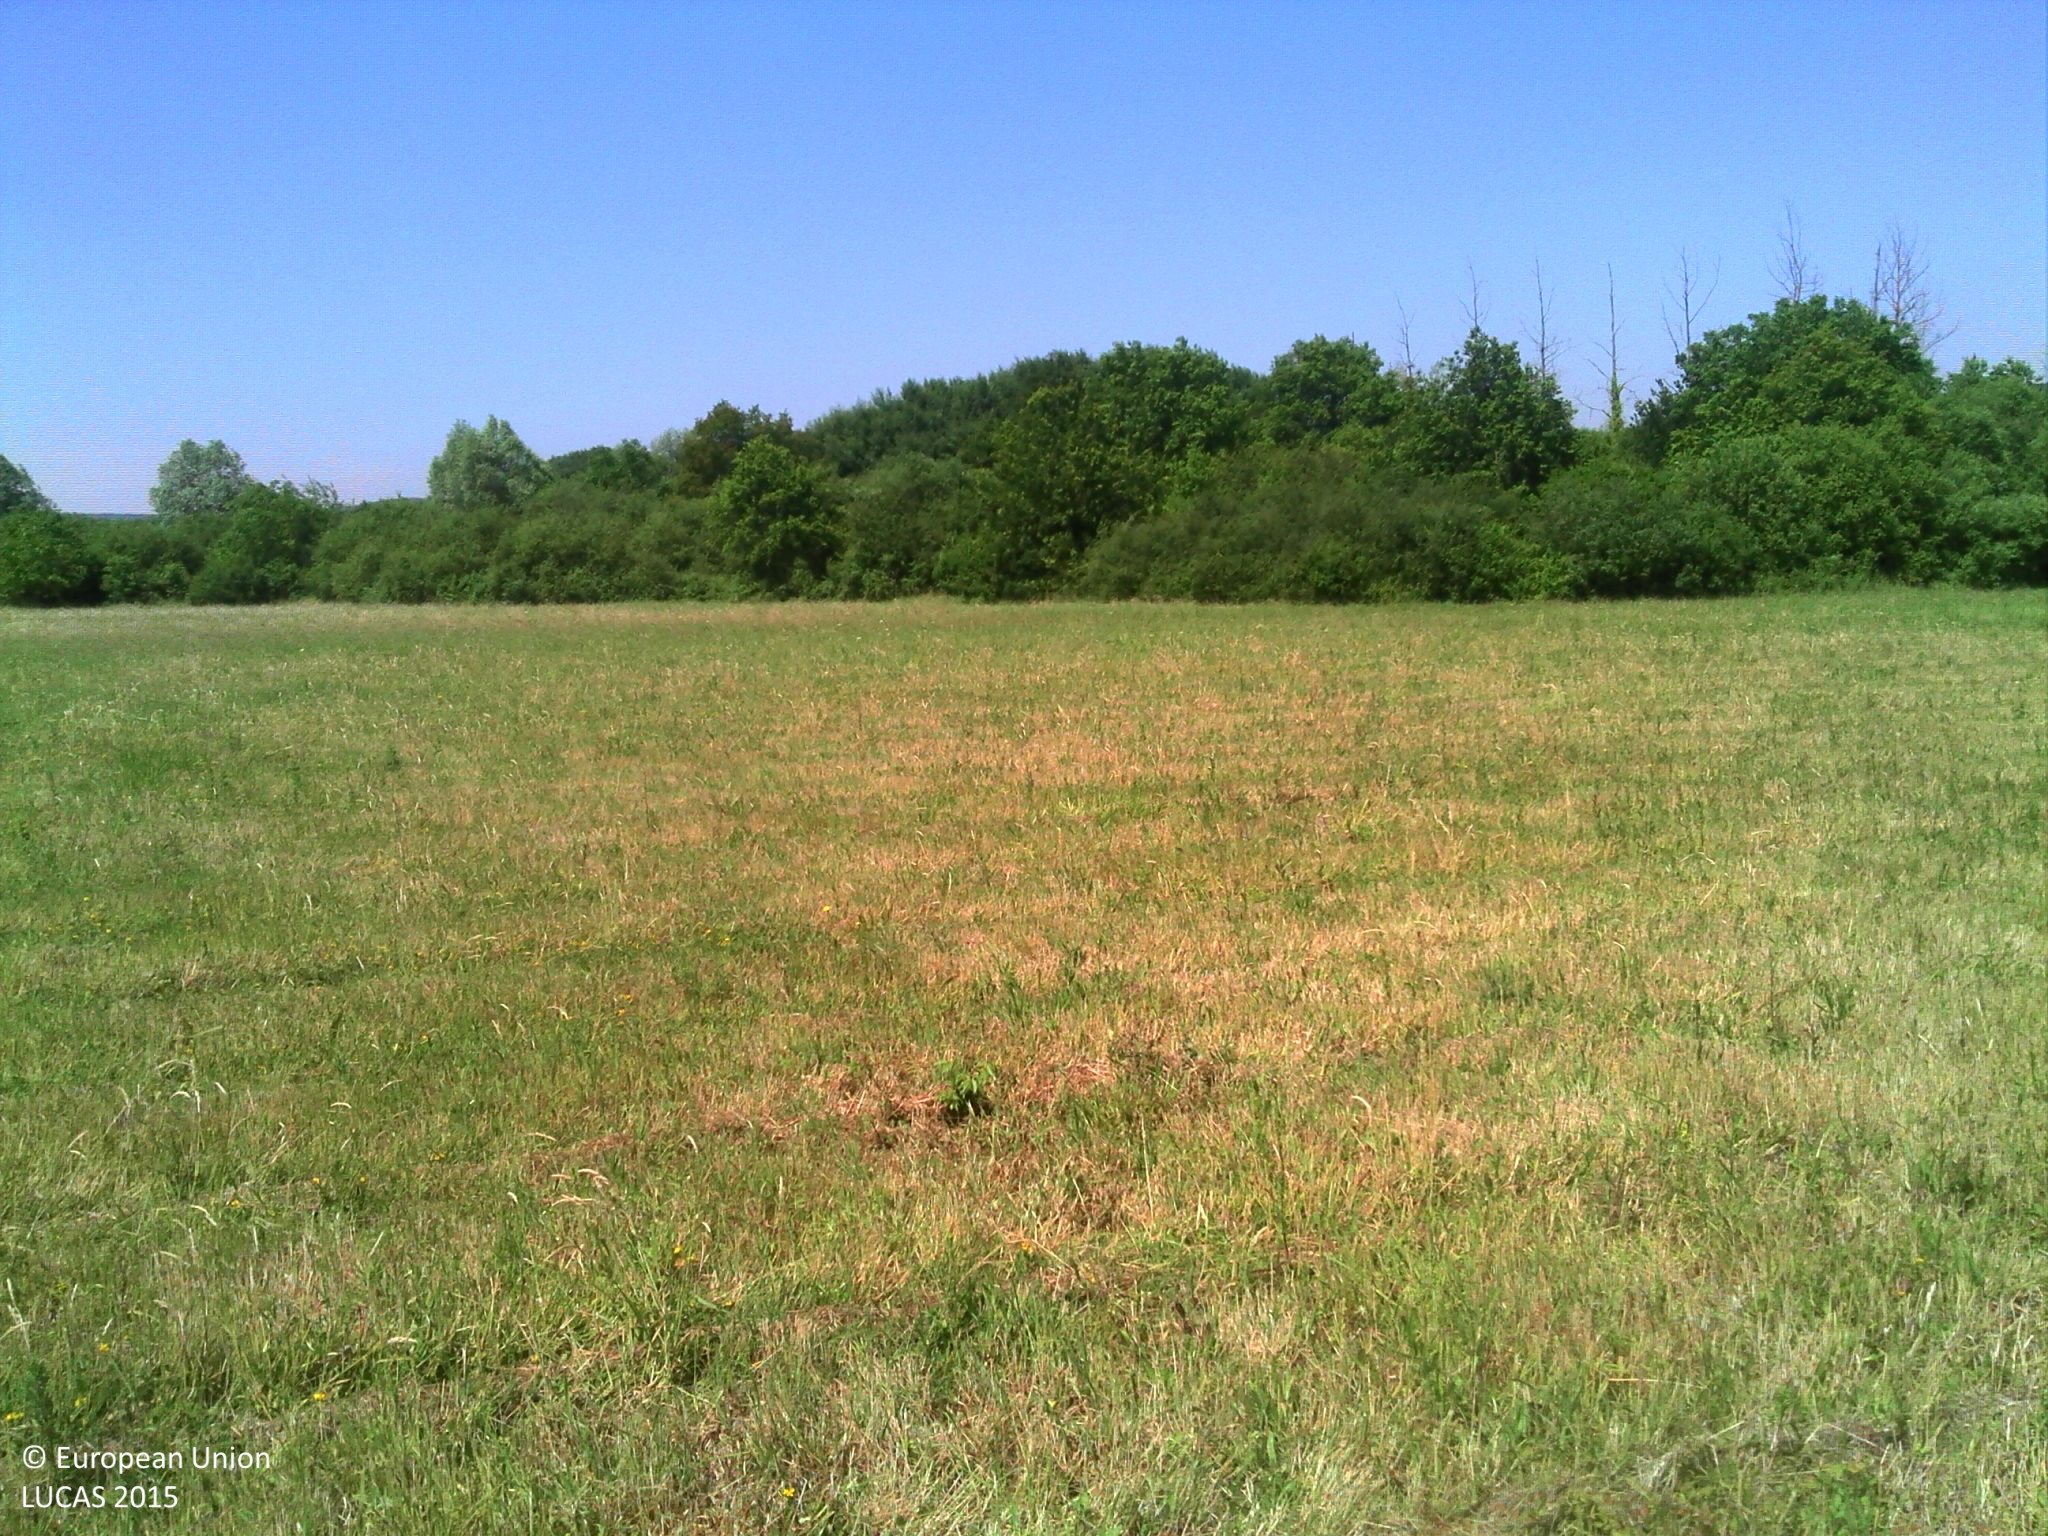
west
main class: Grassland
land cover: Grassland without tree/shrub cover
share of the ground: > 75 %
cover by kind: herbaceous plants 100 %
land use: Agriculture (excluding fallow land and kitchen gardens)
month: June
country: FR
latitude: 47.3271
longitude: 2.9153
